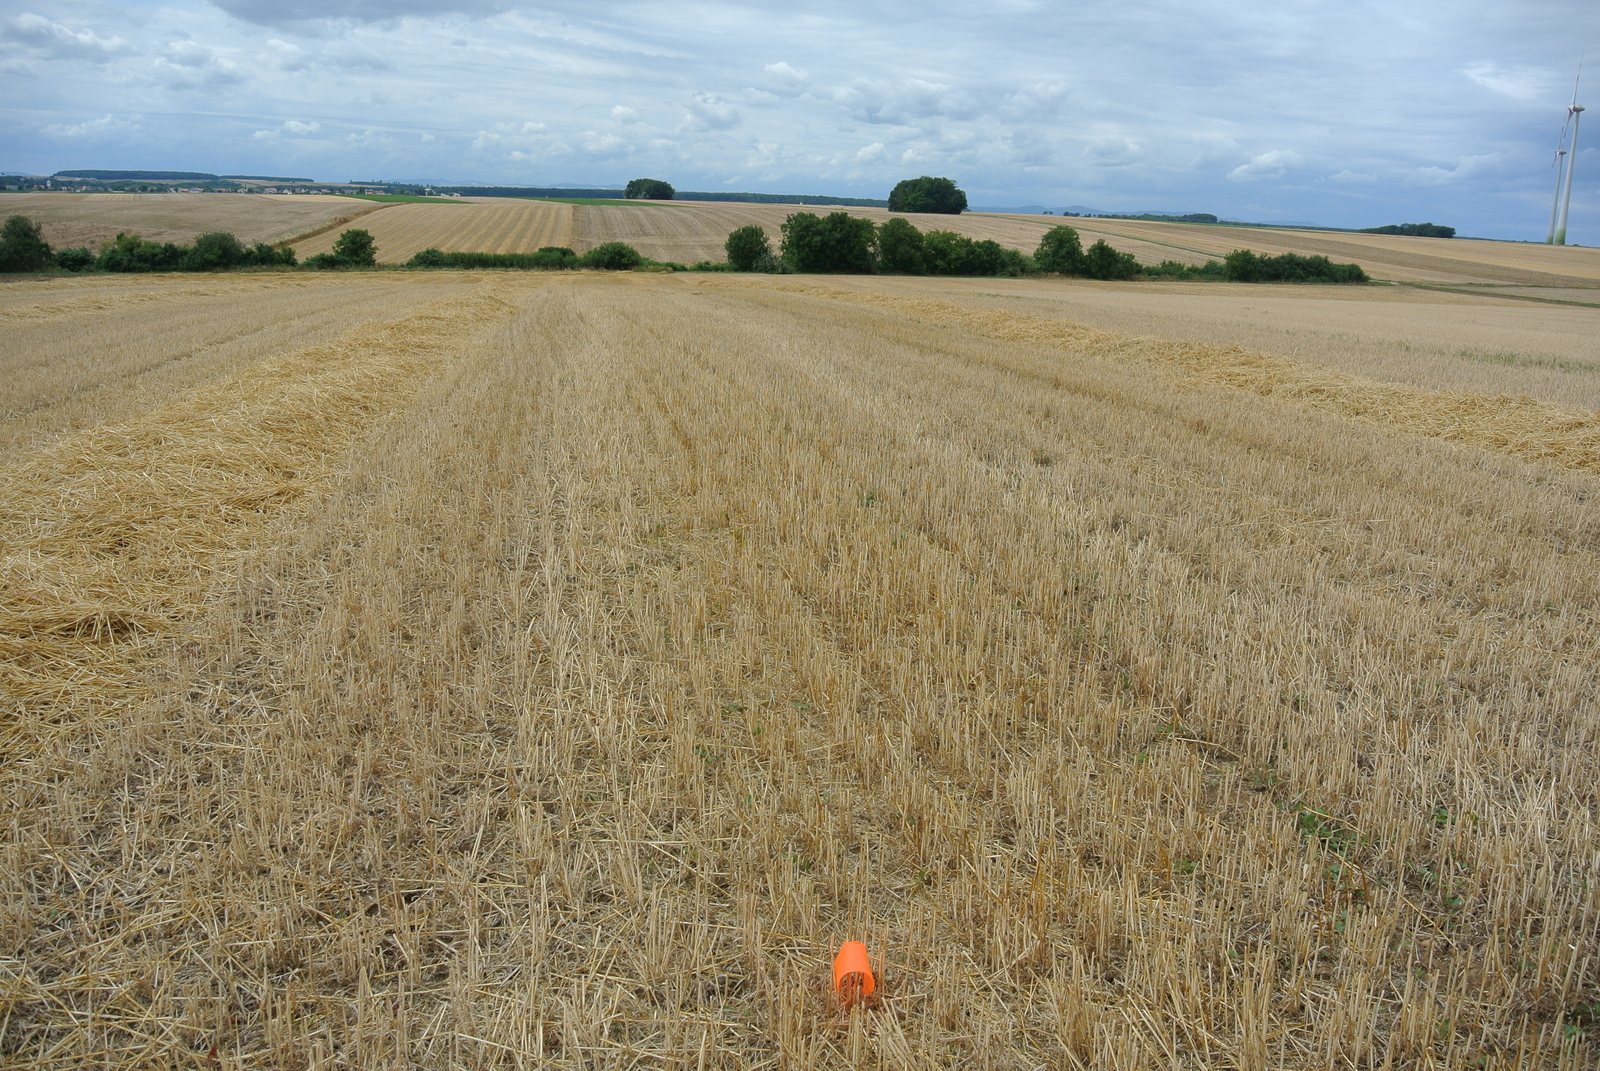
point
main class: Cropland
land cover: Durum wheat
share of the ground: > 75 %
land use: Agriculture (excluding fallow land and kitchen gardens)
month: July
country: AT
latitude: 47.5509
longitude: 16.6885
